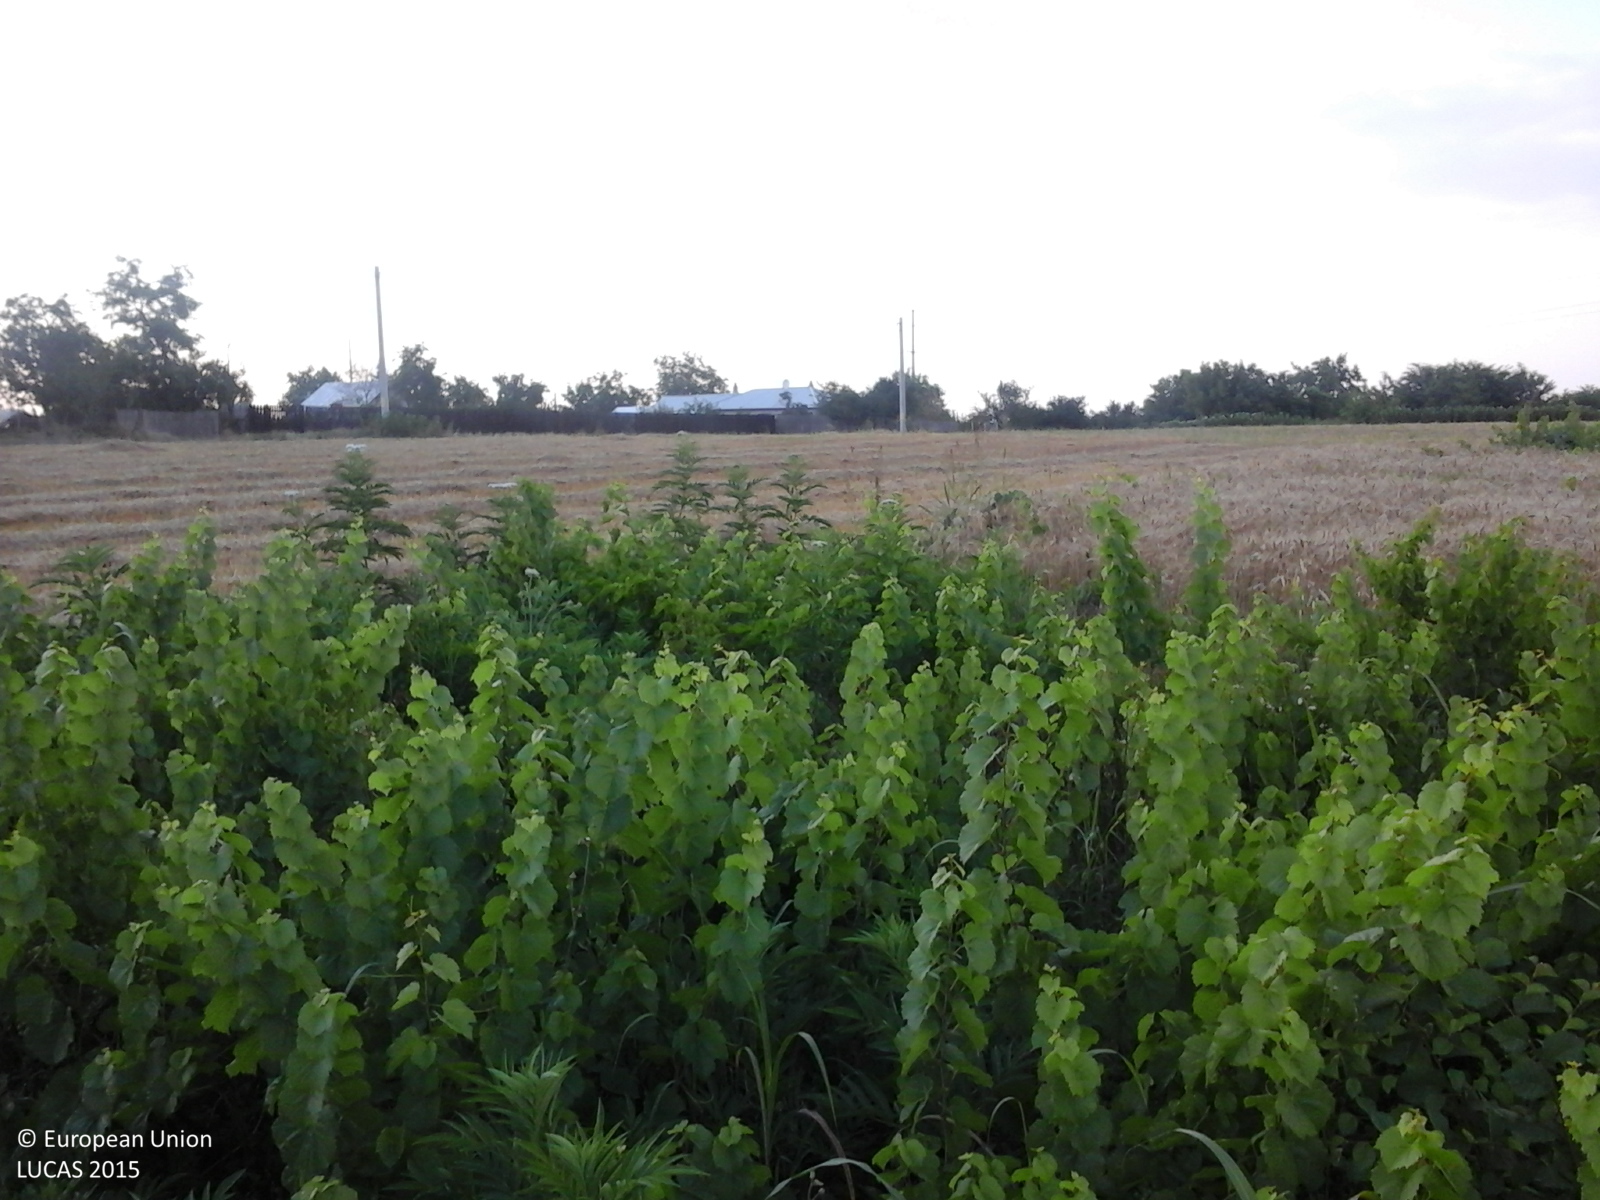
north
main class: Cropland
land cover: Vineyards
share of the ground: > 75 %
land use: Agriculture (excluding fallow land and kitchen gardens)
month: July
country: RO
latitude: 43.9190
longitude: 25.9245
